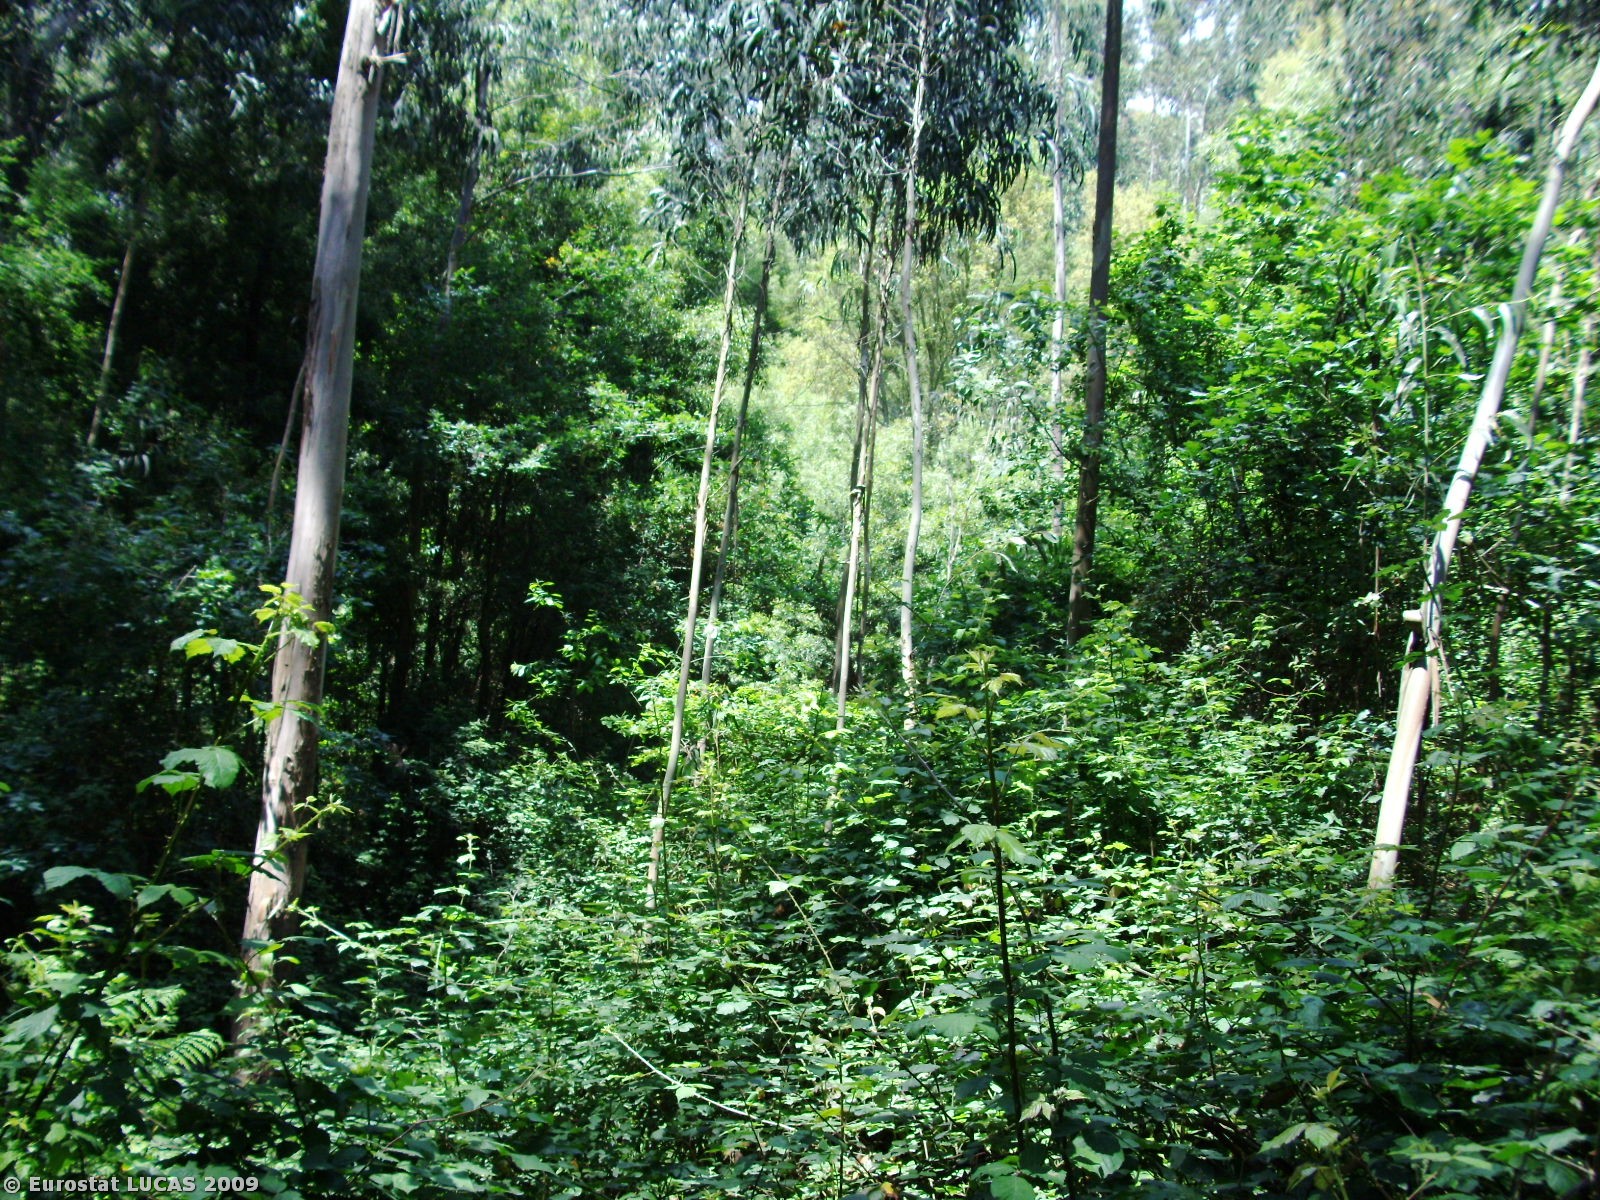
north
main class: Woodland
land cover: Broadleaved woodland
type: plantations and self-sown exotic forest
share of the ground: > 75 %
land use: Forestry
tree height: > 5 m
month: May
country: PT
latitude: 41.0816
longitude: -8.5888
